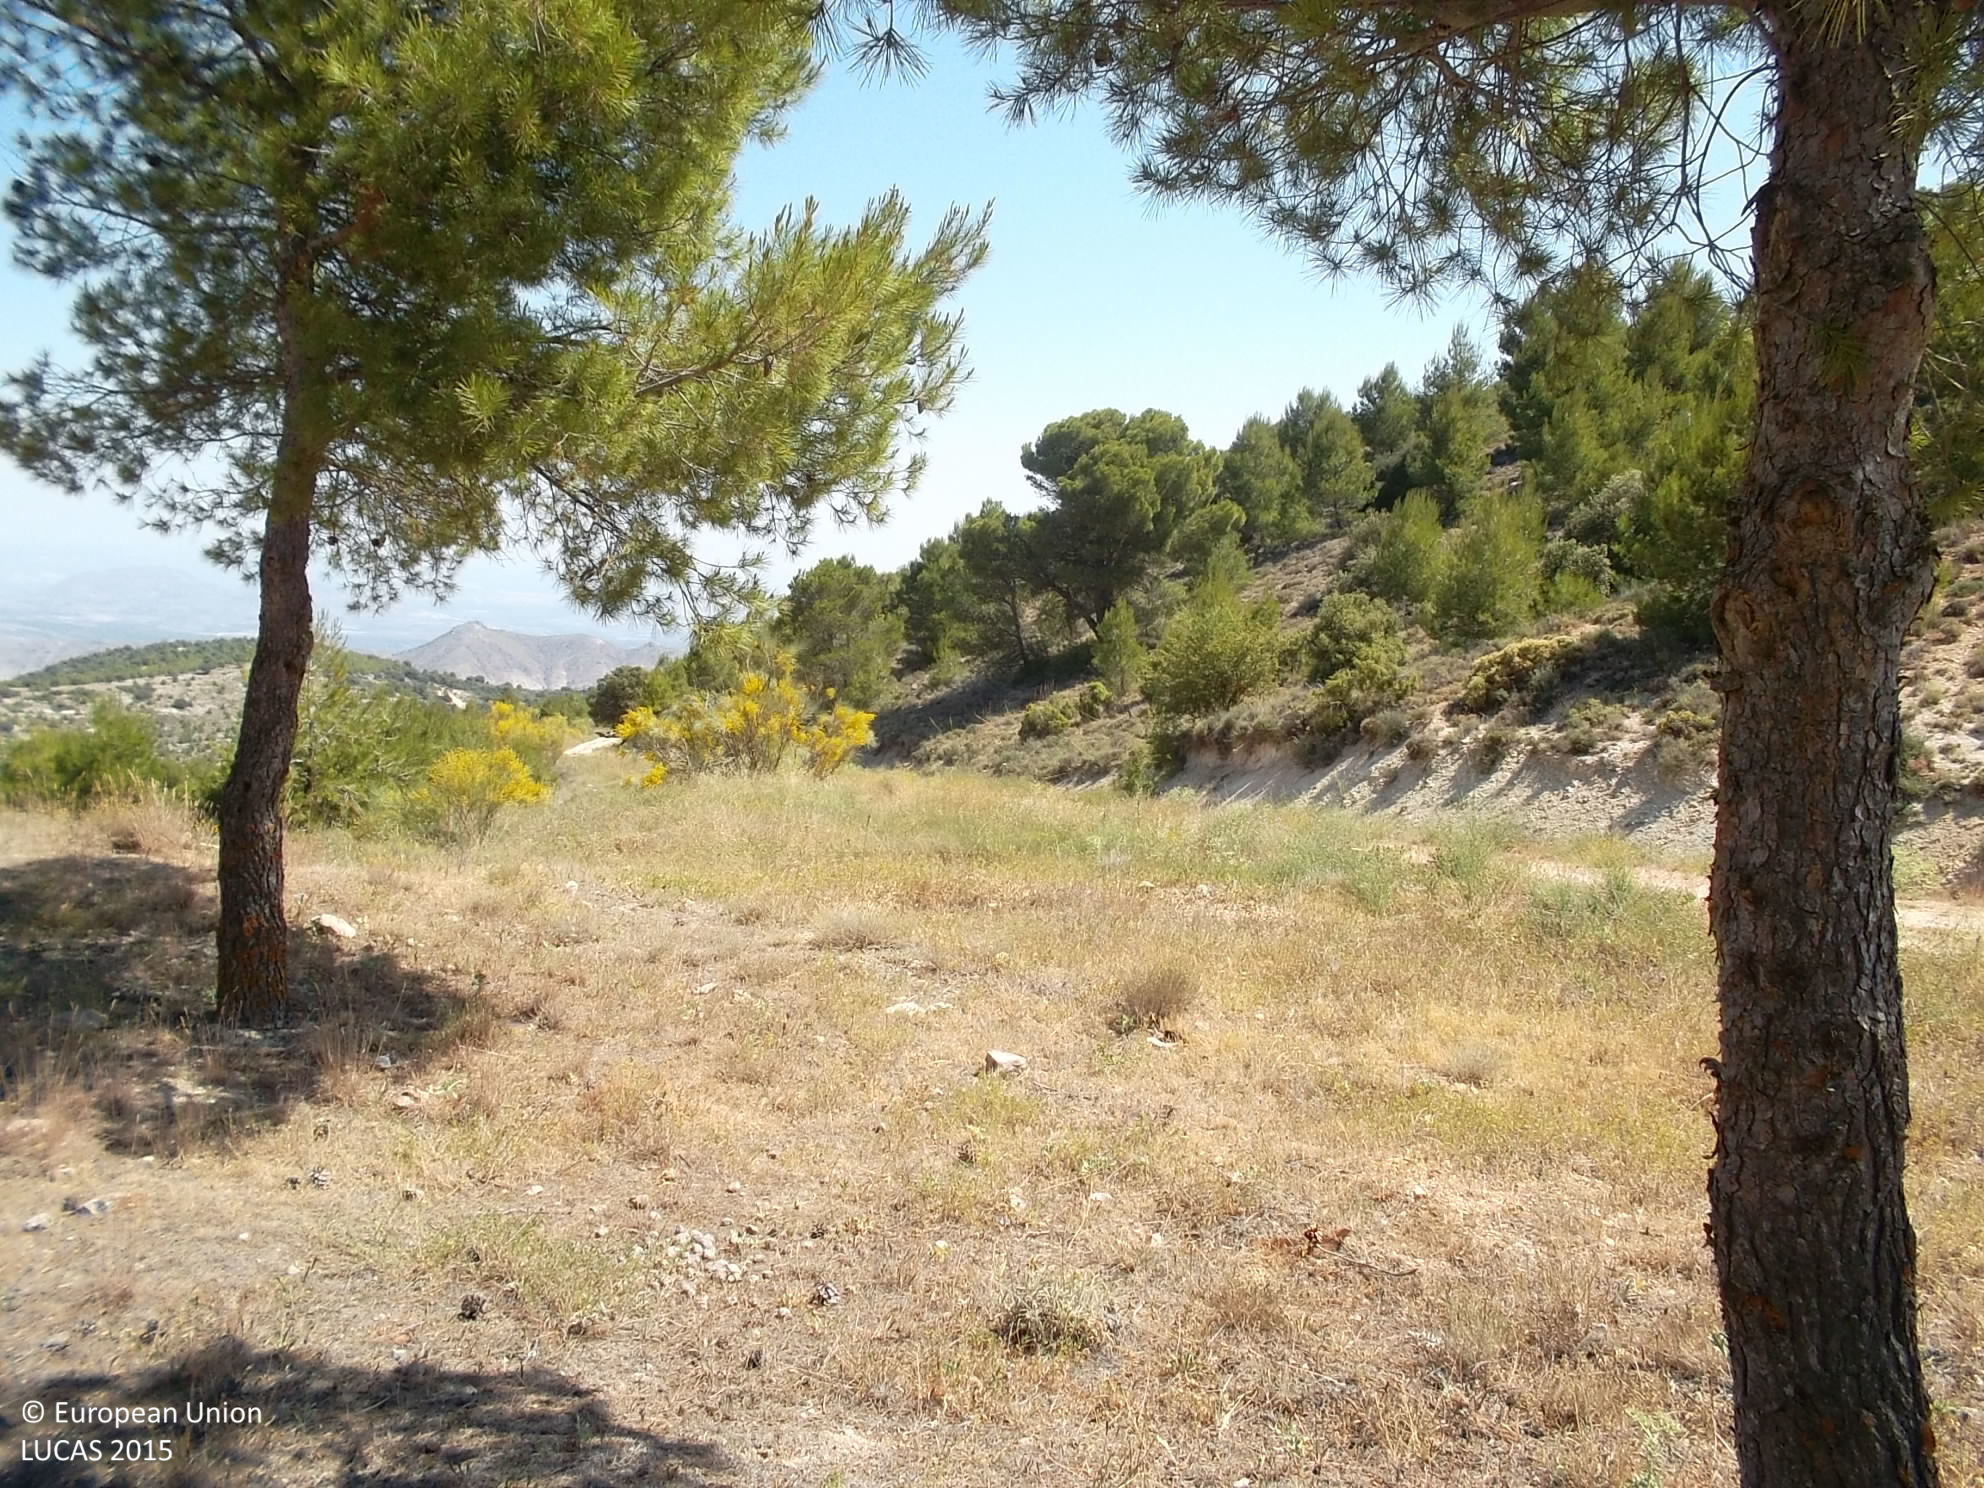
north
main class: Woodland
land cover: Pine dominated coniferous woodland
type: alpine coniferous forest
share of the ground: 25 - 50 %
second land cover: Spontaneously vegetated surfaces
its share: > 75 %
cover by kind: herbaceous plants 50 %, coniferous forest trees 30 %, unconsolidated bare surface 20 %
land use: Forestry
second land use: Agriculture (excluding fallow land and kitchen gardens)
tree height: > 5 m
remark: Clear cut
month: June
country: ES
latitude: 37.7048
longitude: -3.3225
